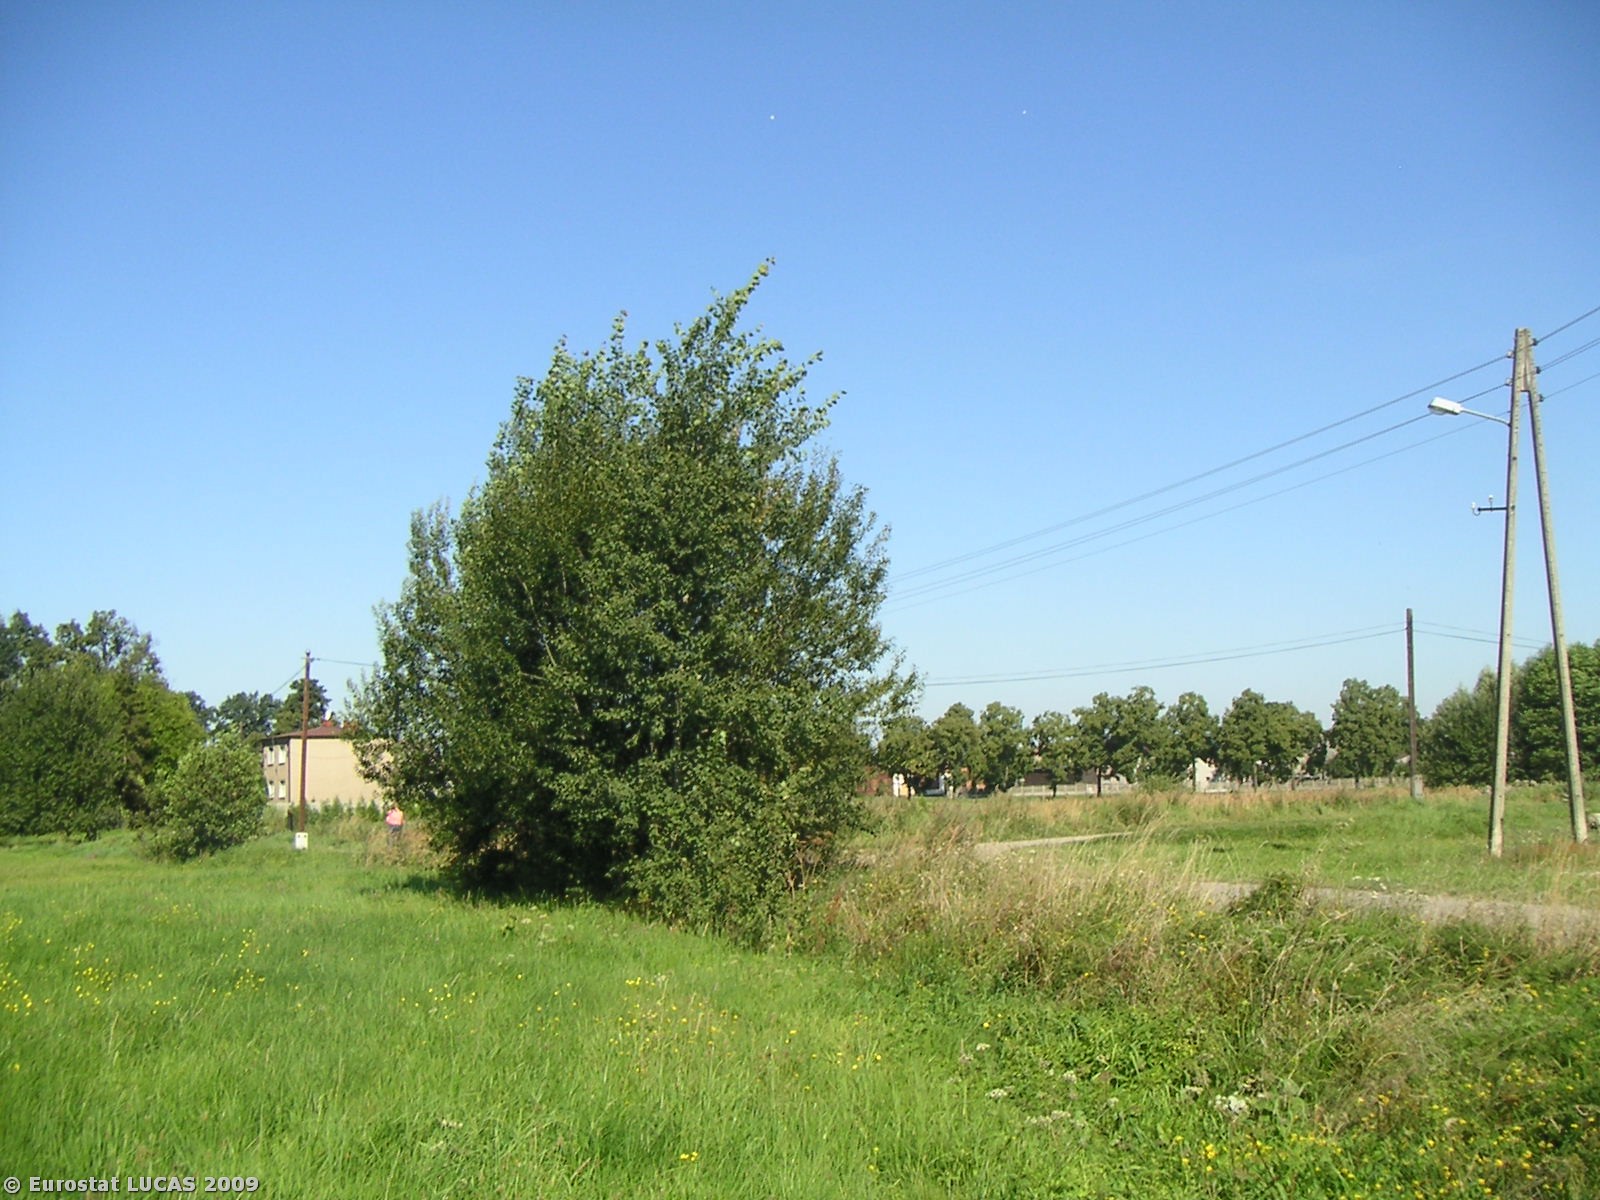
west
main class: Grassland
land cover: Grassland without tree/shrub cover
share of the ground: > 75 %
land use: Agriculture (excluding fallow land and kitchen gardens)
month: August
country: PL
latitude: 50.6927
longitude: 18.8127
